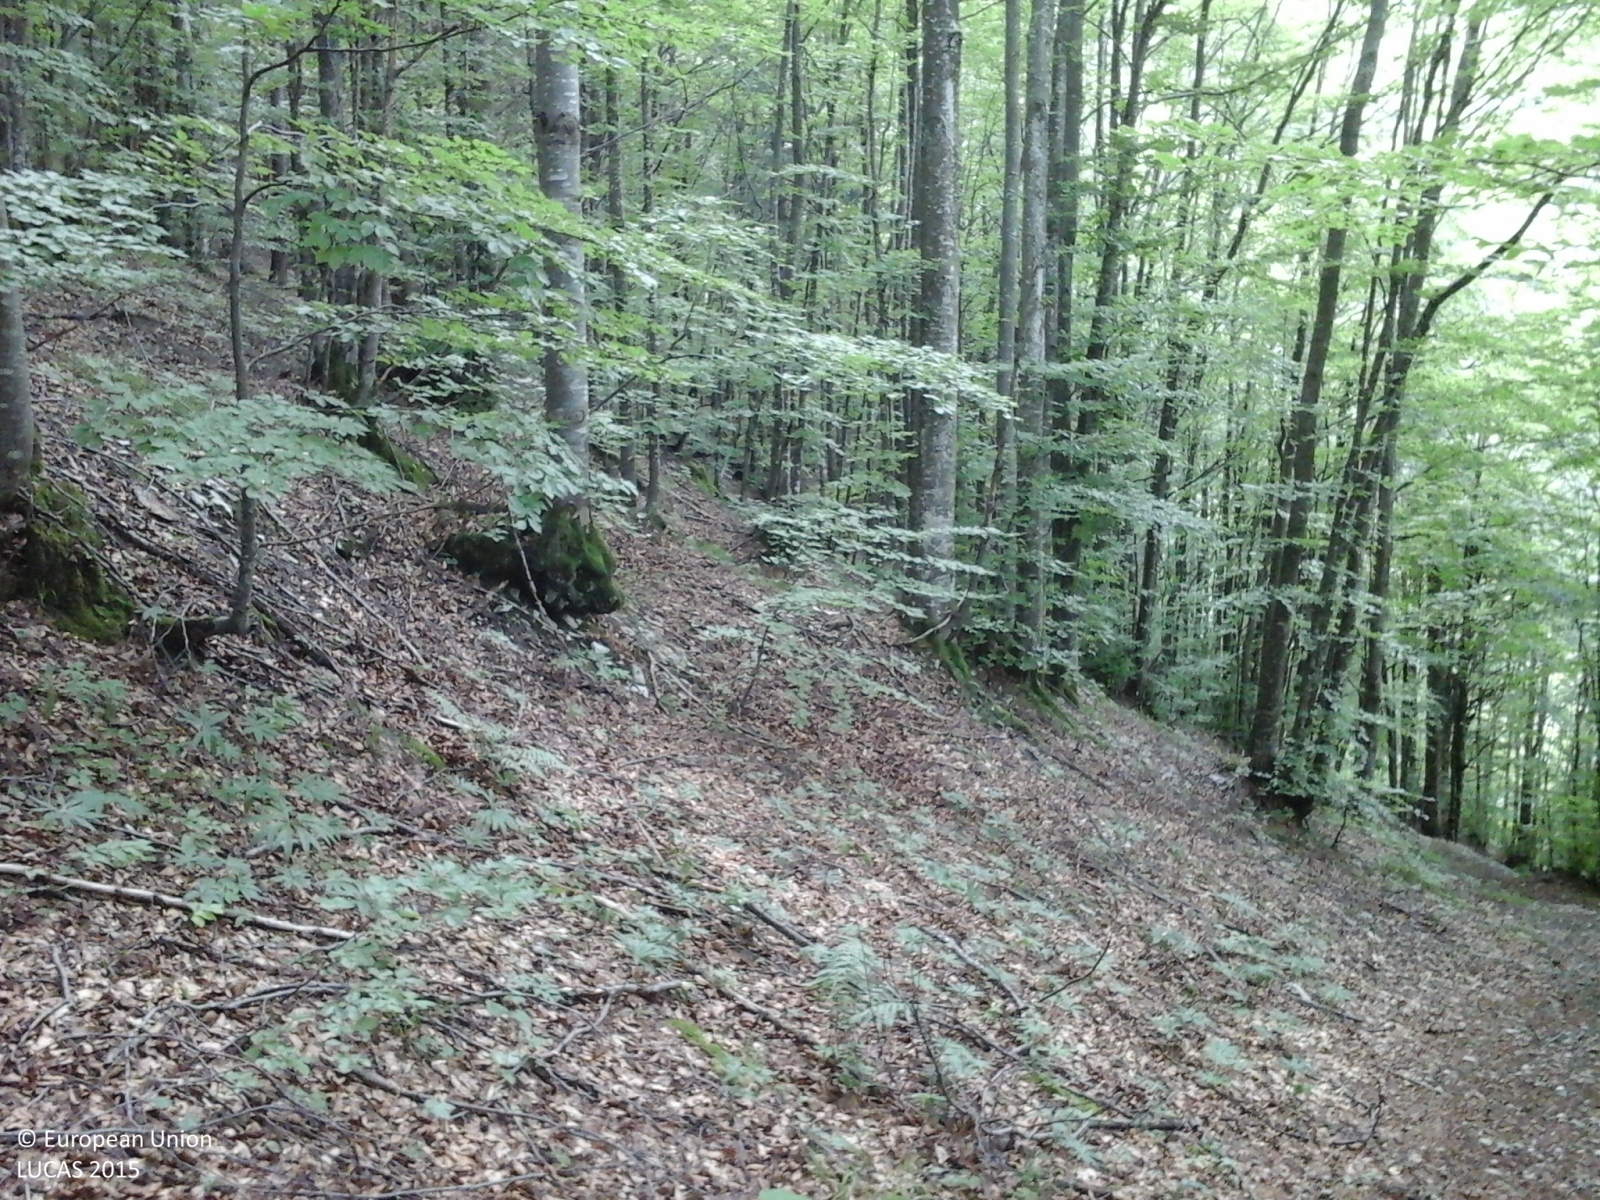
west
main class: Woodland
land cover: Broadleaved woodland
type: mountainous beech forest
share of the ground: > 75 %
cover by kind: broadleaved forest trees 100 %
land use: Forestry
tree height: > 5 m
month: June
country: IT
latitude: 45.8706
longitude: 11.6080
